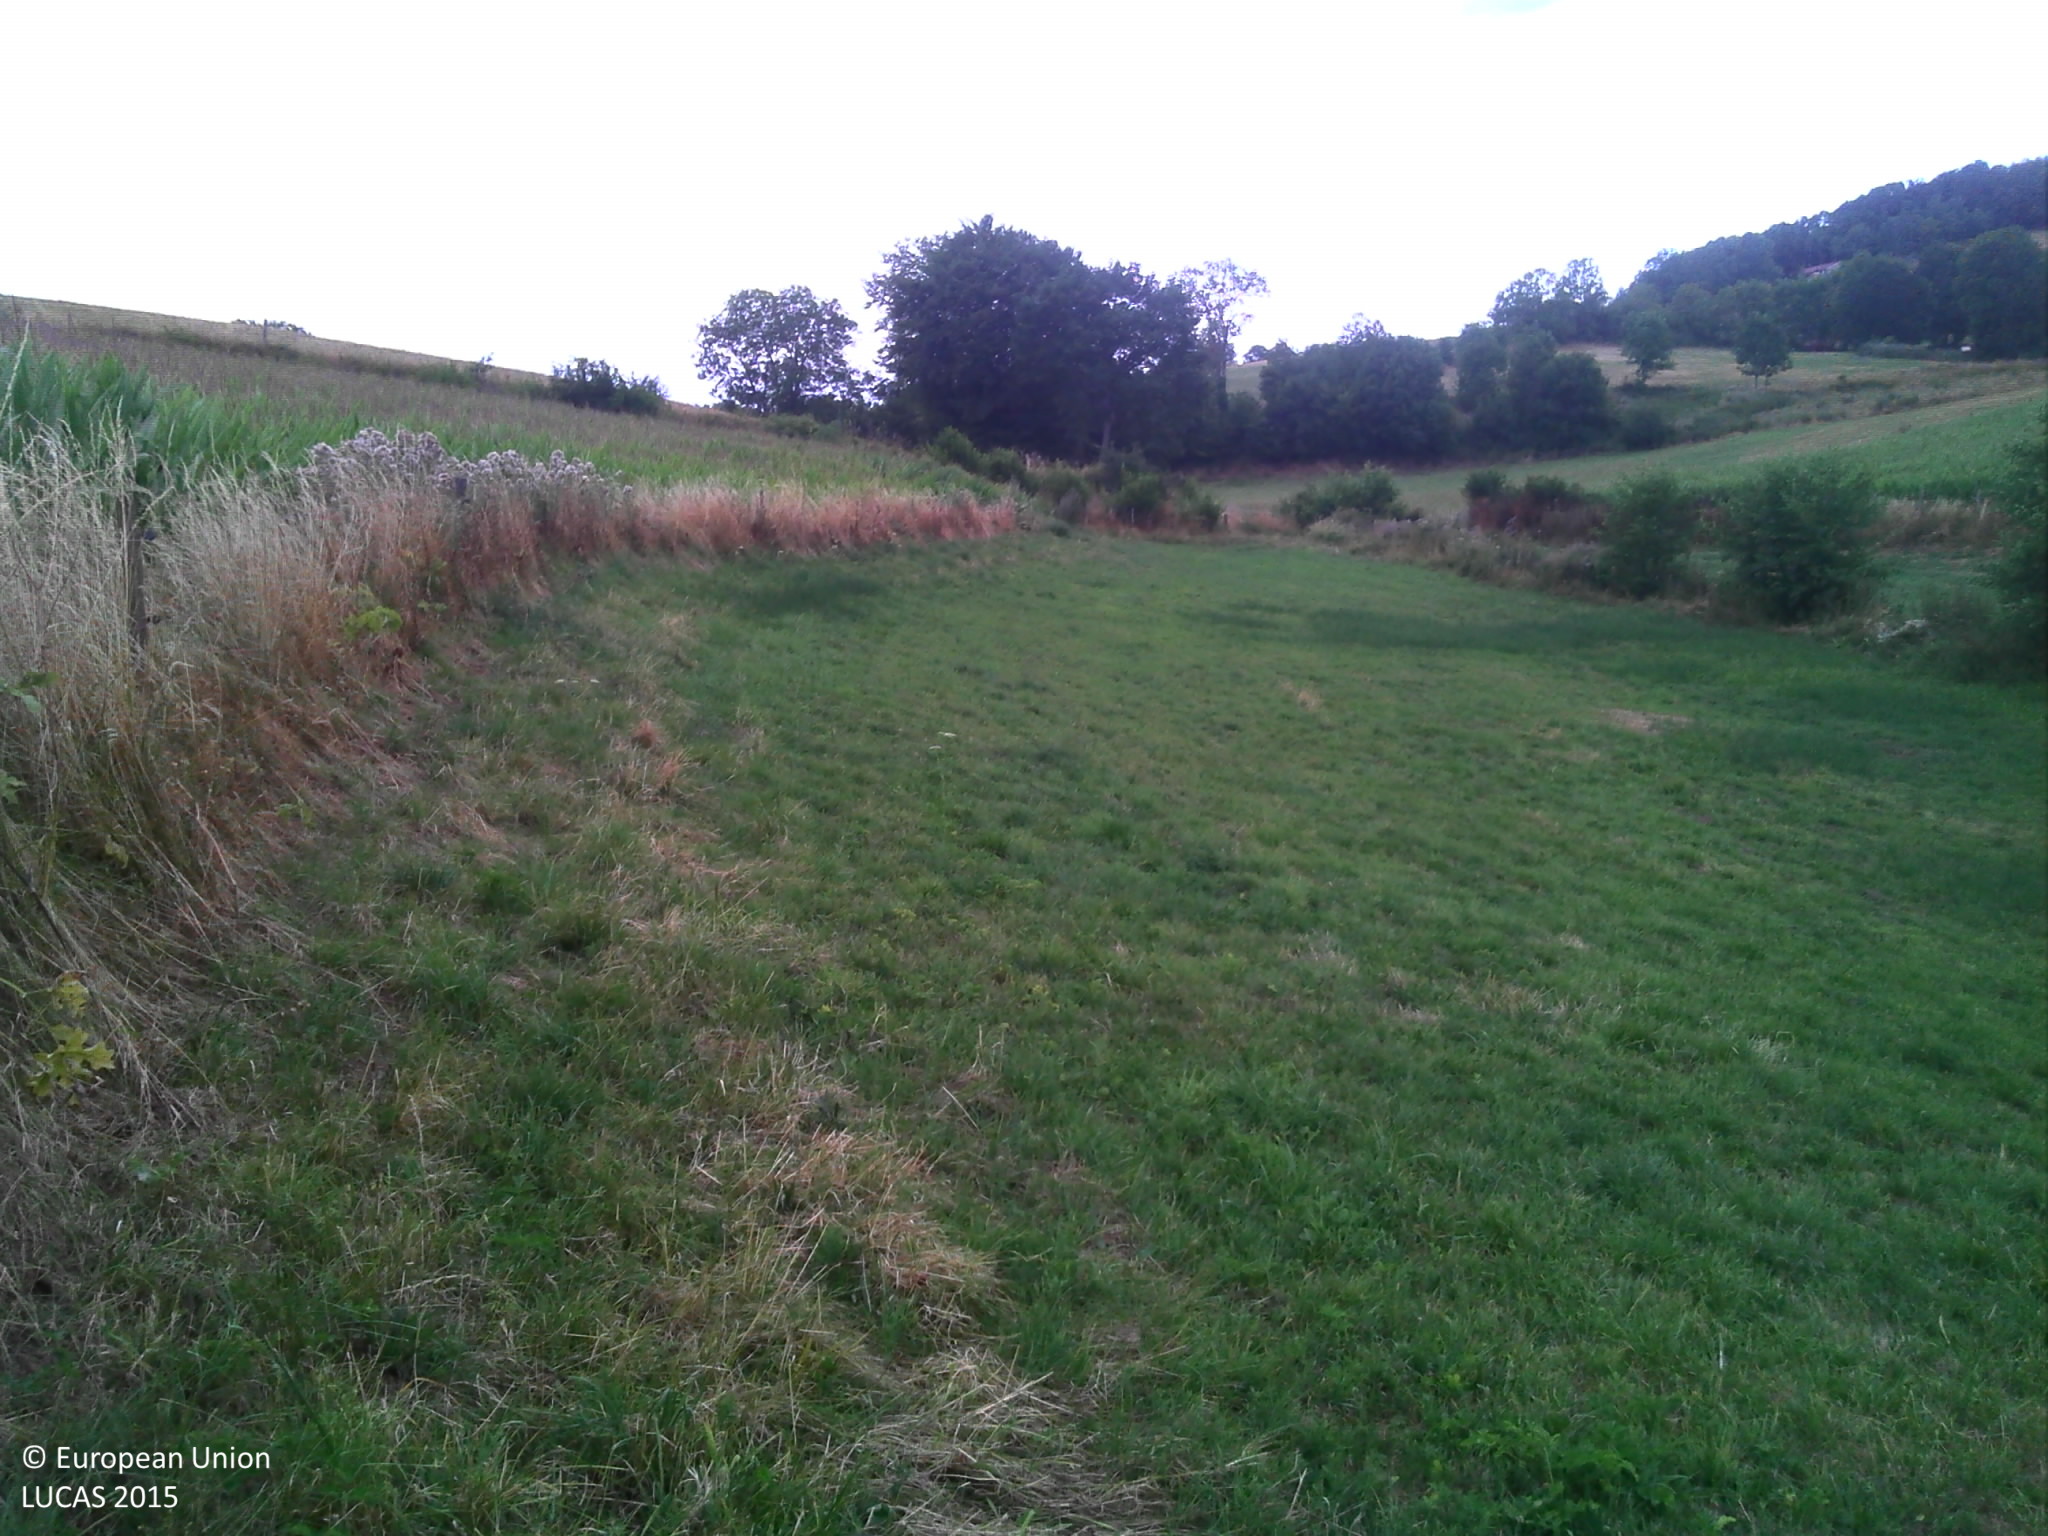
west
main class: Cropland
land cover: Maize
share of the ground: > 75 %
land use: Agriculture (excluding fallow land and kitchen gardens)
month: July
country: FR
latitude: 45.5807
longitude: 4.5569
